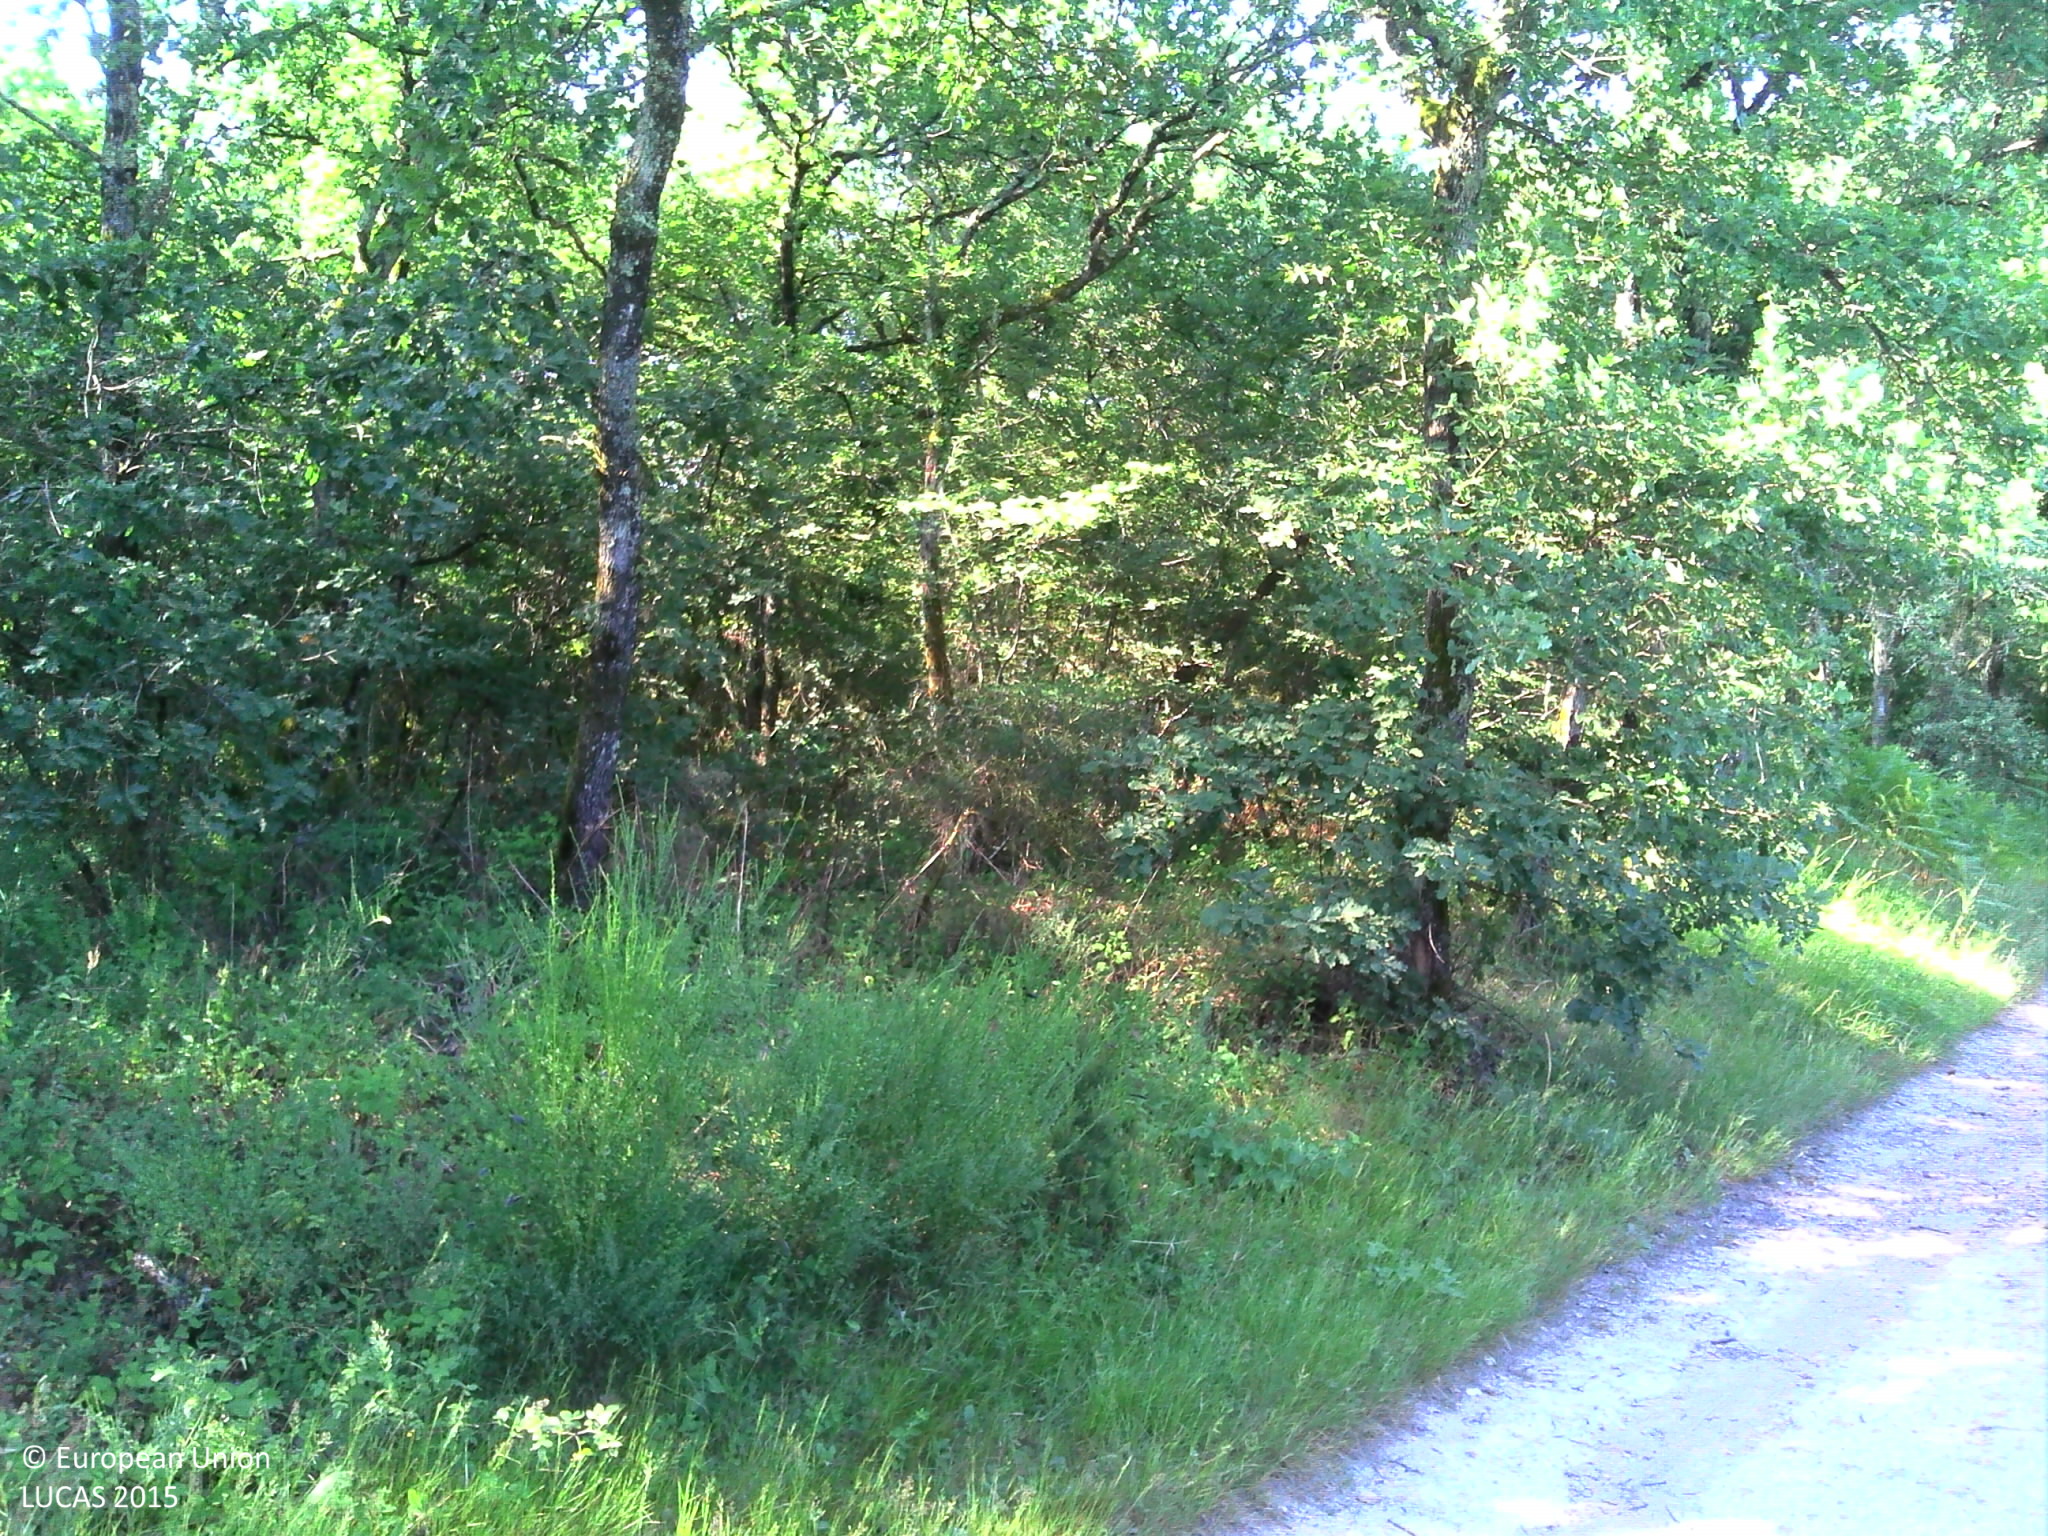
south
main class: Grassland
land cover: Spontaneously vegetated surfaces
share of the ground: > 75 %
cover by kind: herbaceous plants 60 %, lichens and mosses 15 %, shrubs 5 %
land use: Forestry
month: June
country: FR
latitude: 43.7711
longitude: 1.5669
